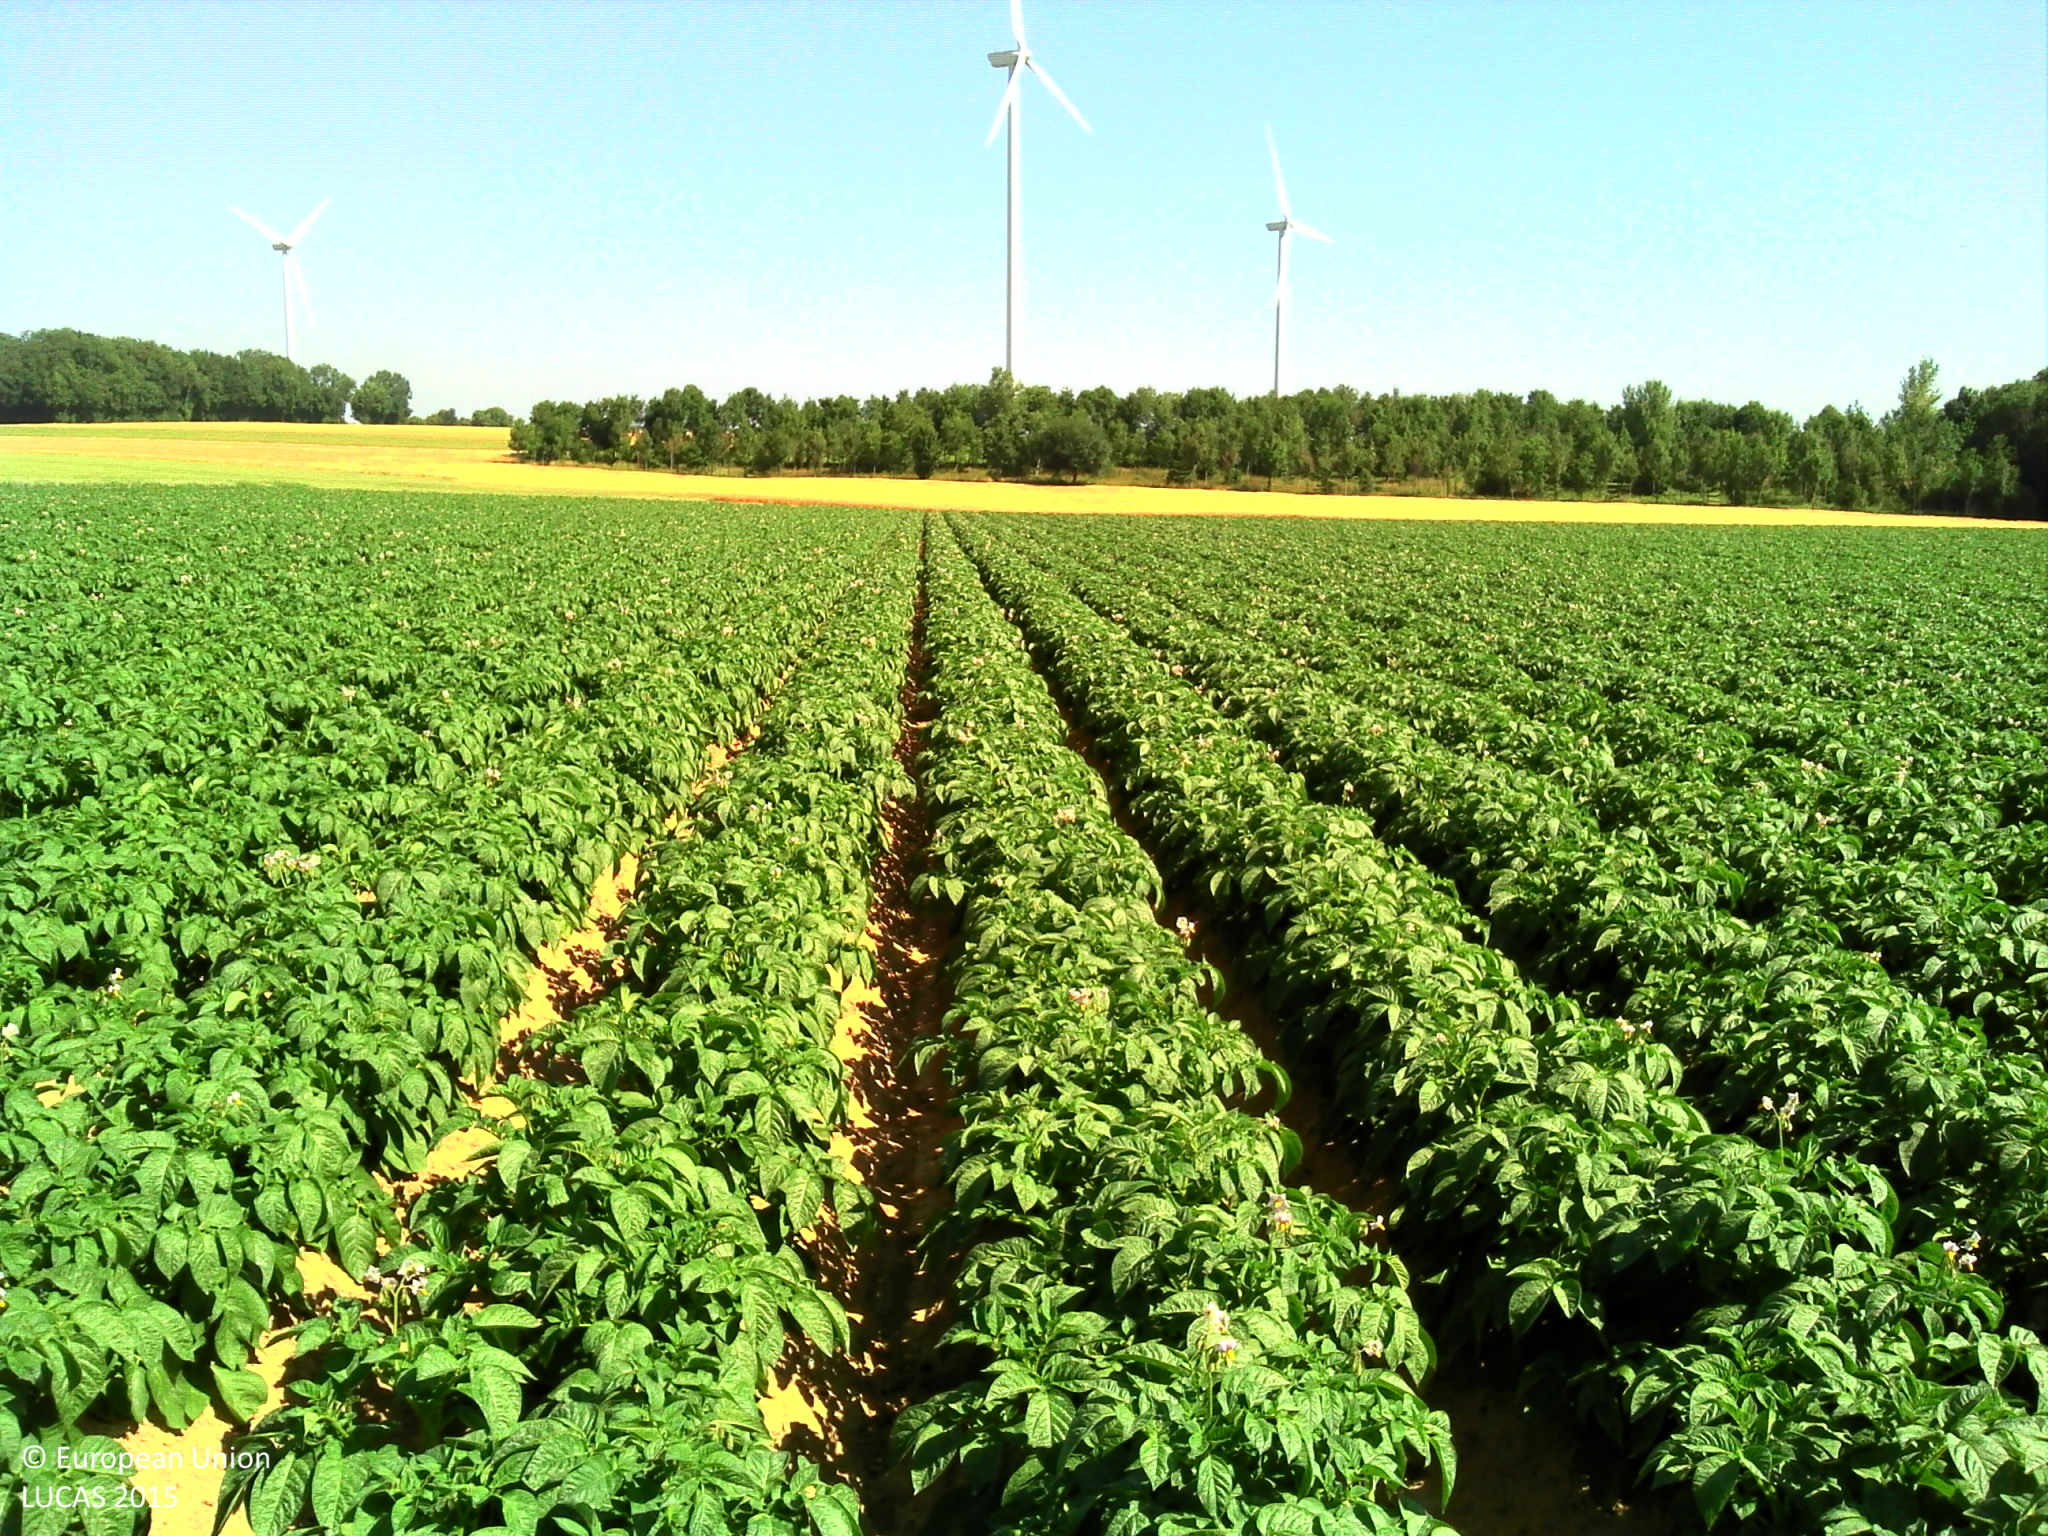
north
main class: Cropland
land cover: Potatoes
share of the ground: > 75 %
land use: Agriculture (excluding fallow land and kitchen gardens)
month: June
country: FR
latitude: 50.3343
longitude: 2.4992
